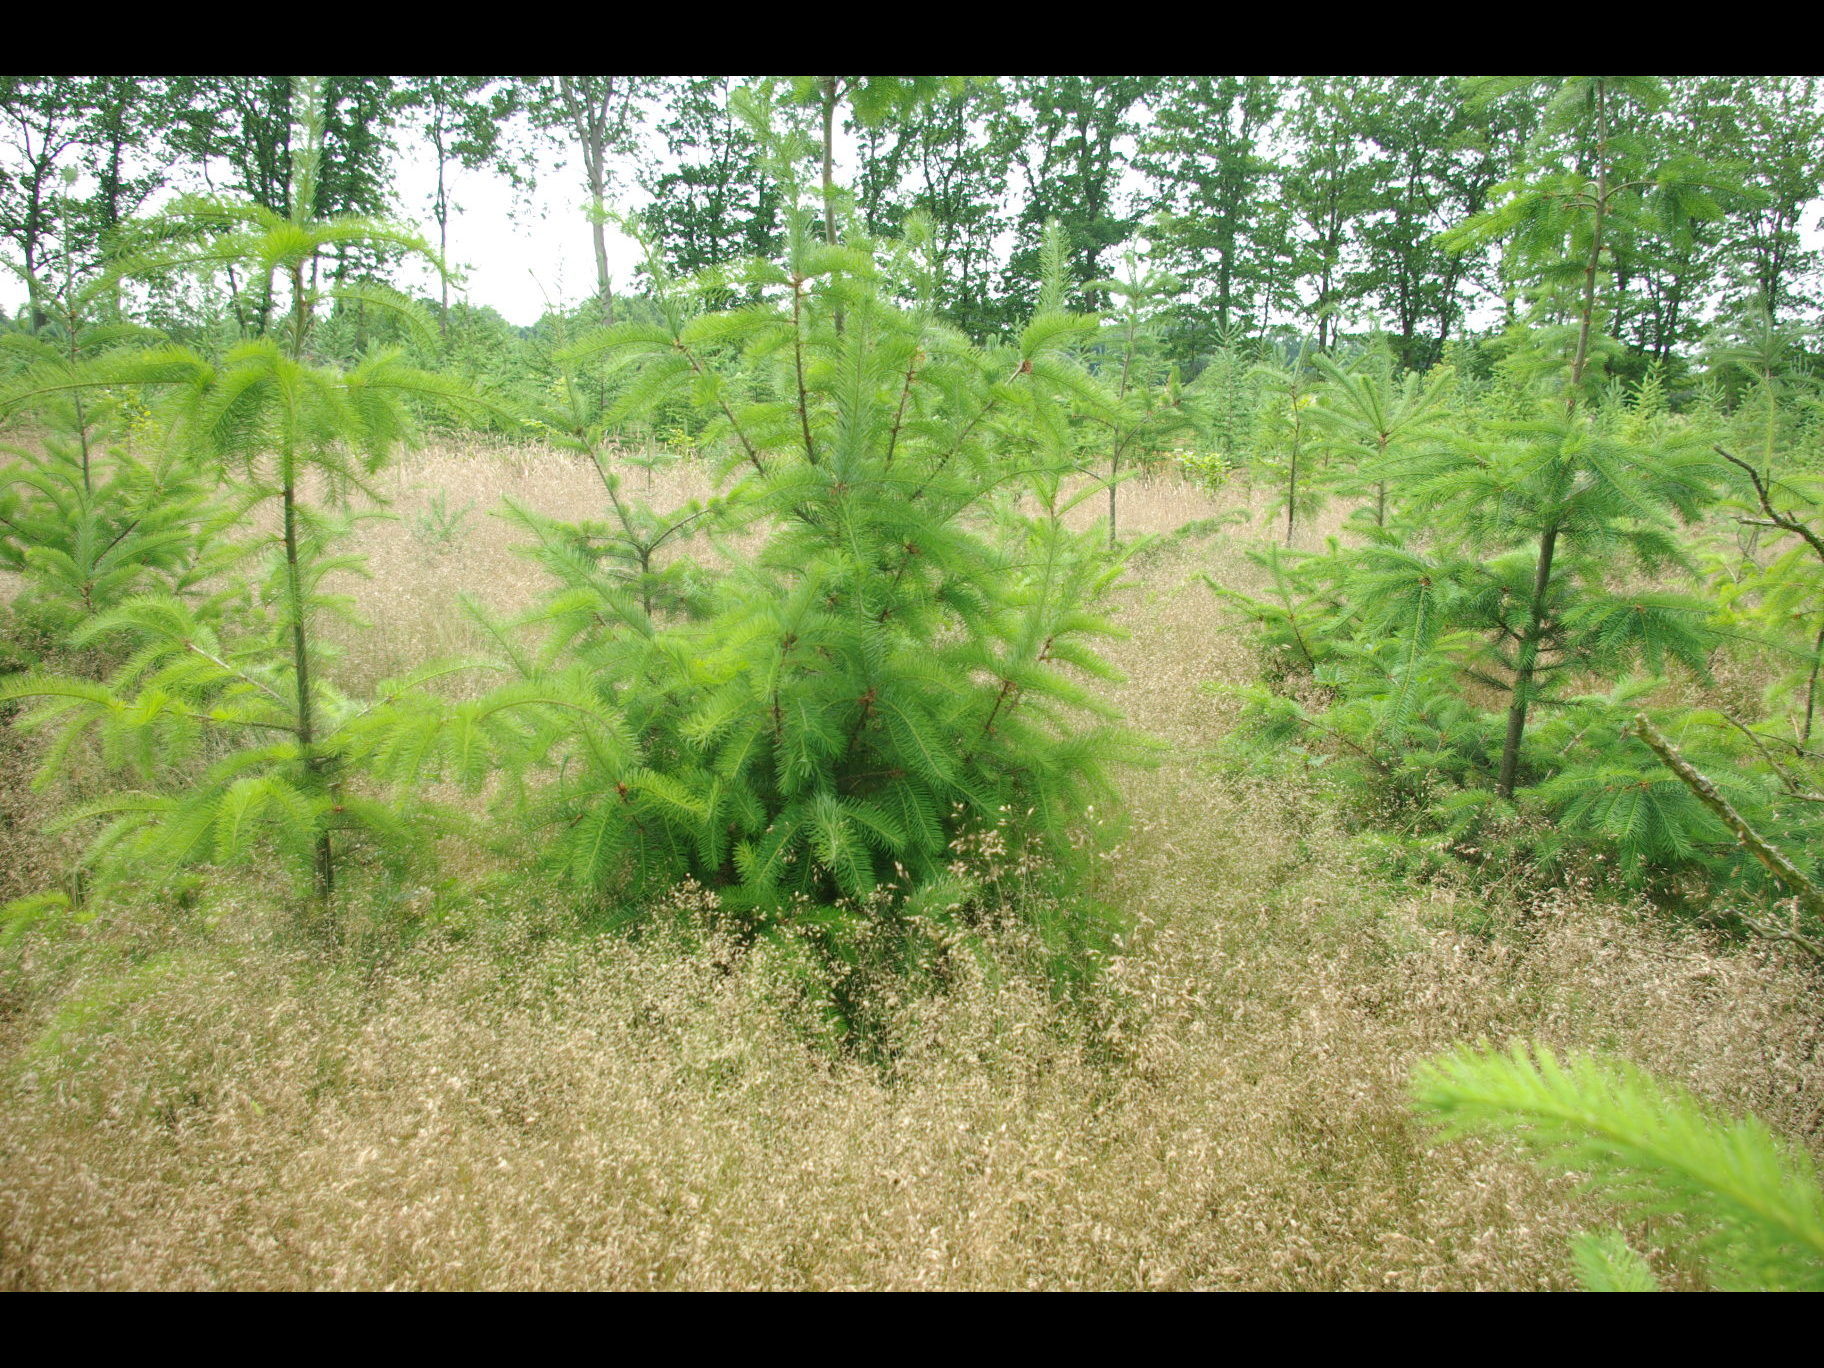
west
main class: Woodland
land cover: Other coniferous woodland
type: hemiboreal forest and nemoral coniferous forest and mixed broadleaved-coniferous forest
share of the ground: 50 - 75 %
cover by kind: coniferous forest trees 50 %, herbaceous plants 40 %, broadleaved forest trees 5 %, shrubs 5 %
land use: Forestry
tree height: < 5 m
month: July
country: DE
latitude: 54.1922
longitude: 9.6477
